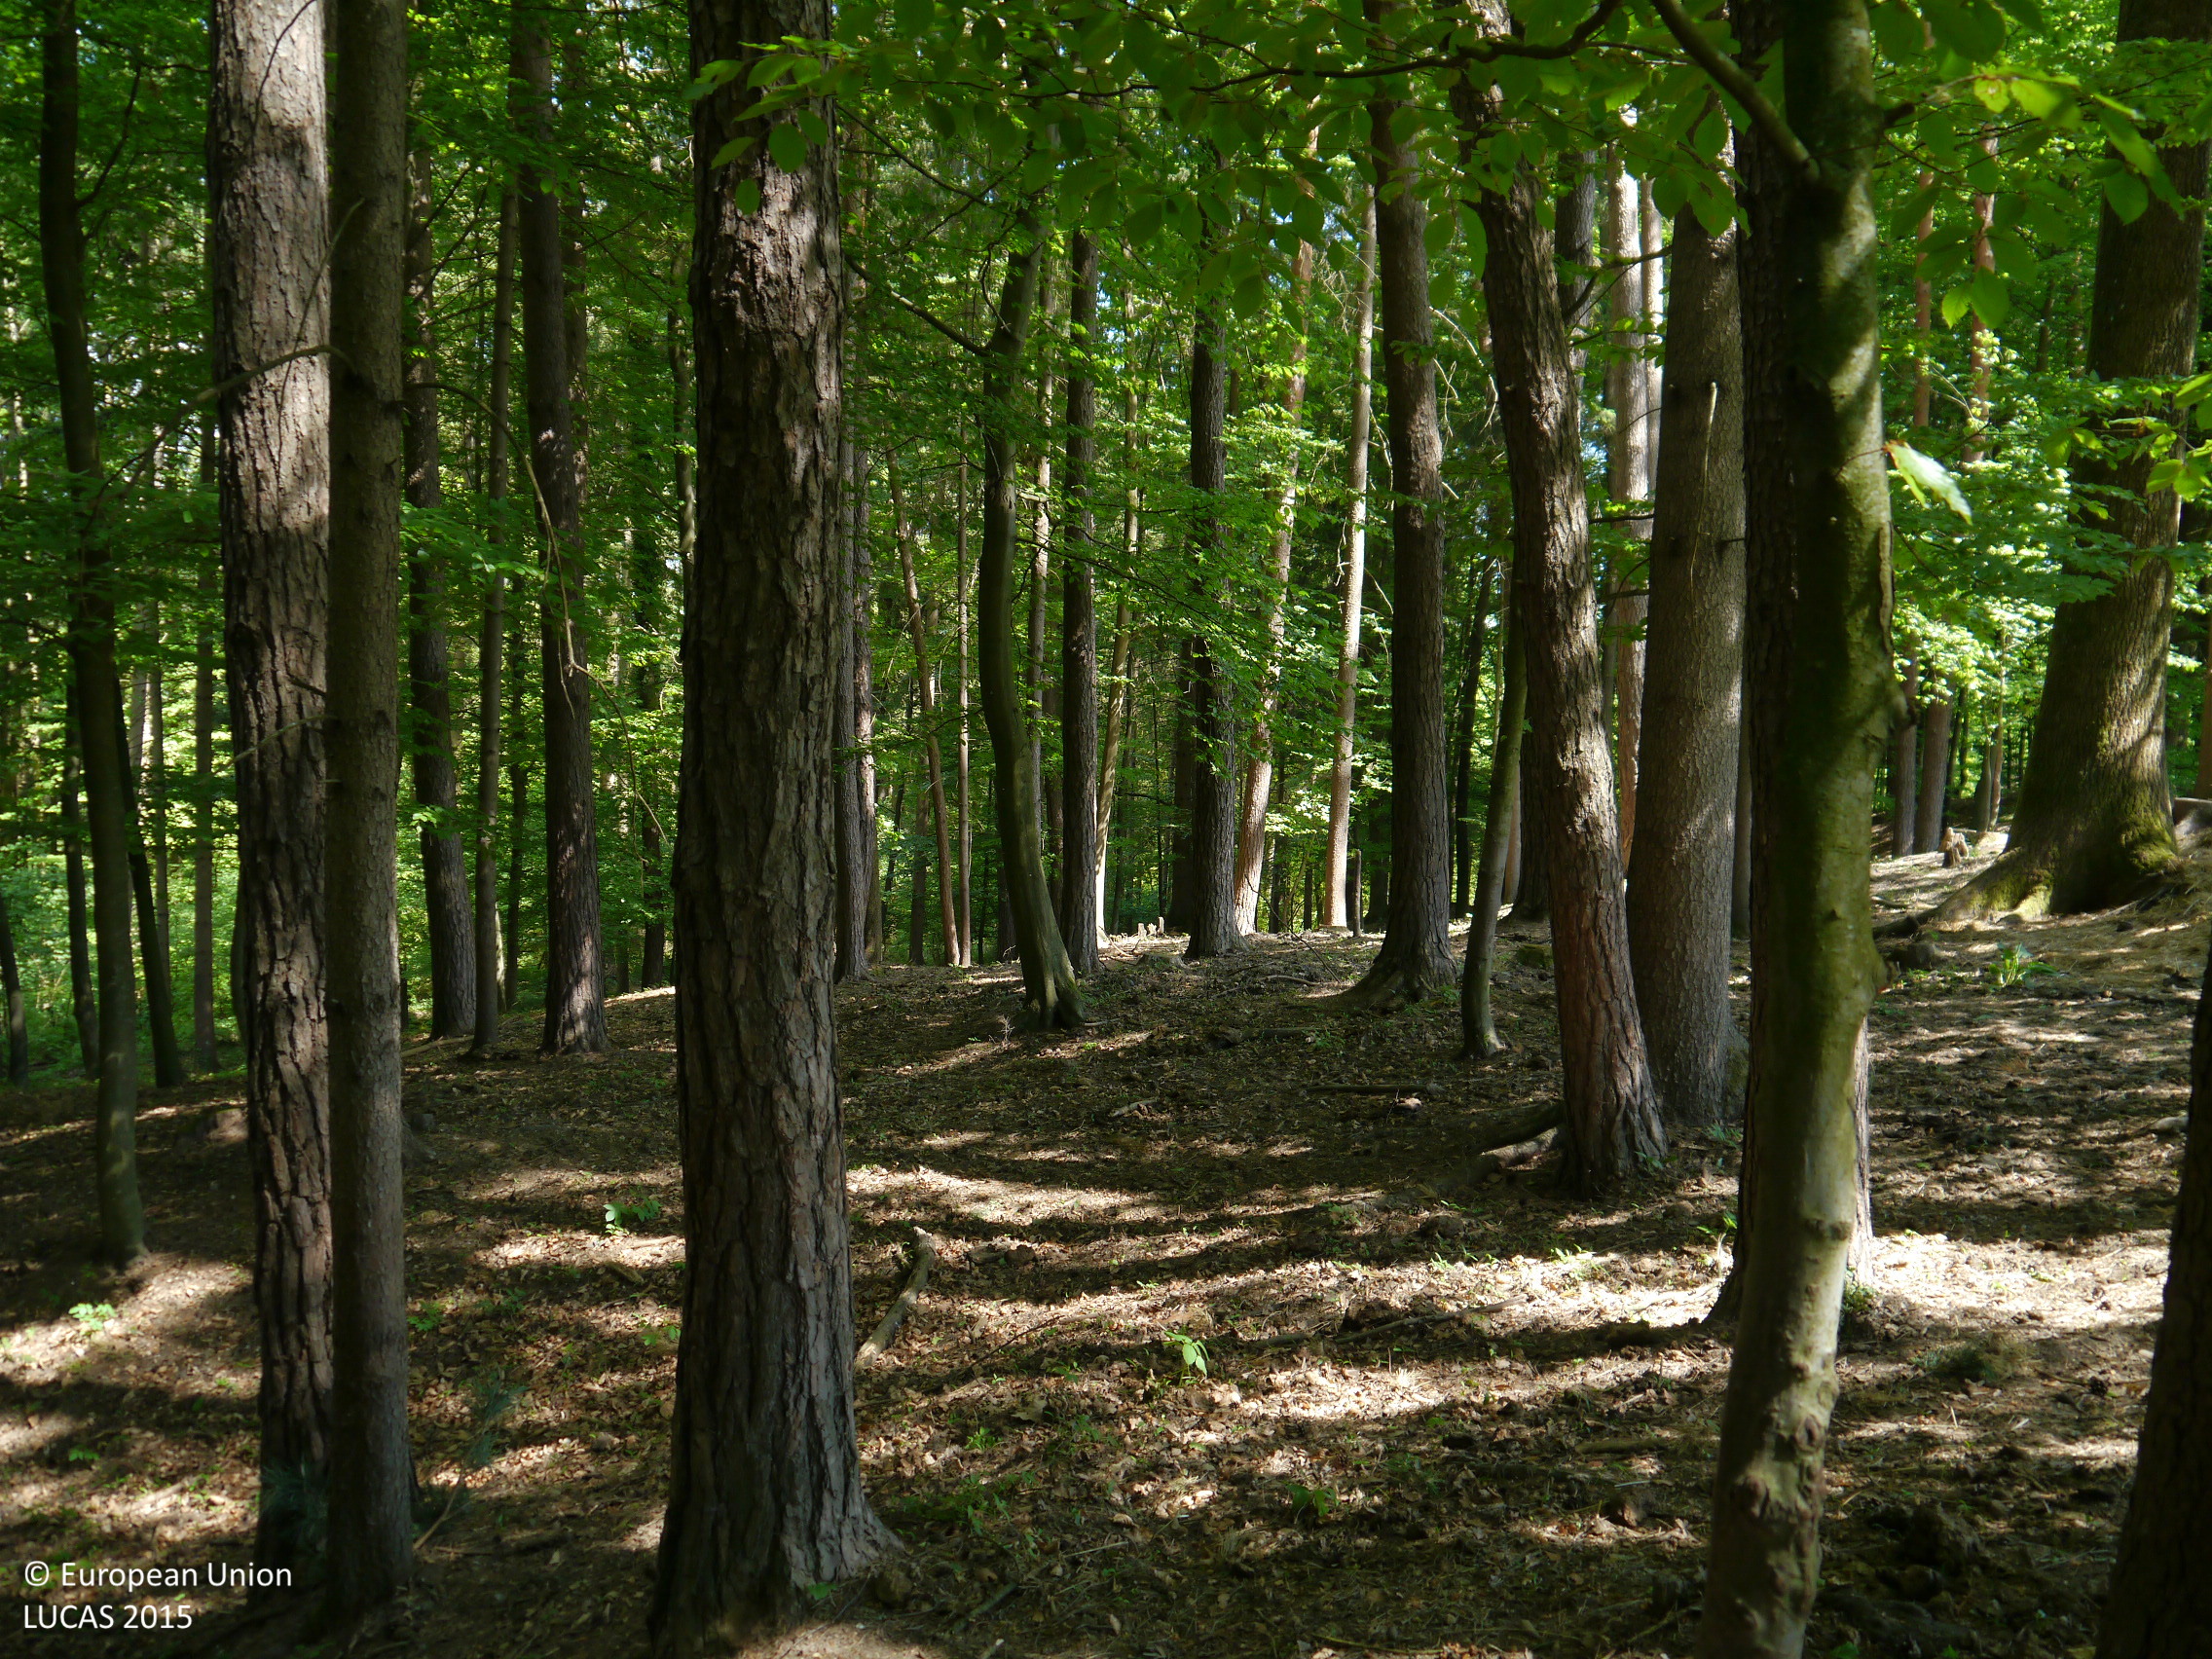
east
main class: Woodland
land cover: Spruce dominated mixed woodland
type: hemiboreal forest and nemoral coniferous forest and mixed broadleaved-coniferous forest
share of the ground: > 75 %
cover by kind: coniferous forest trees 50 %, broadleaved forest trees 45 %, unconsolidated bare surface 5 %
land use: Forestry
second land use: Agriculture (excluding fallow land and kitchen gardens)
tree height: > 5 m
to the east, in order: Spruce dominated mixed woodland; Fences; Tracks; Spruce dominated coniferous woodland; Tracks; Broadleaved woodland; Rivers and streams; Broadleaved woodland; Spruce dominated coniferous woodland; Broadleaved woodland
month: May
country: AT
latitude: 47.0484
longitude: 15.3306
